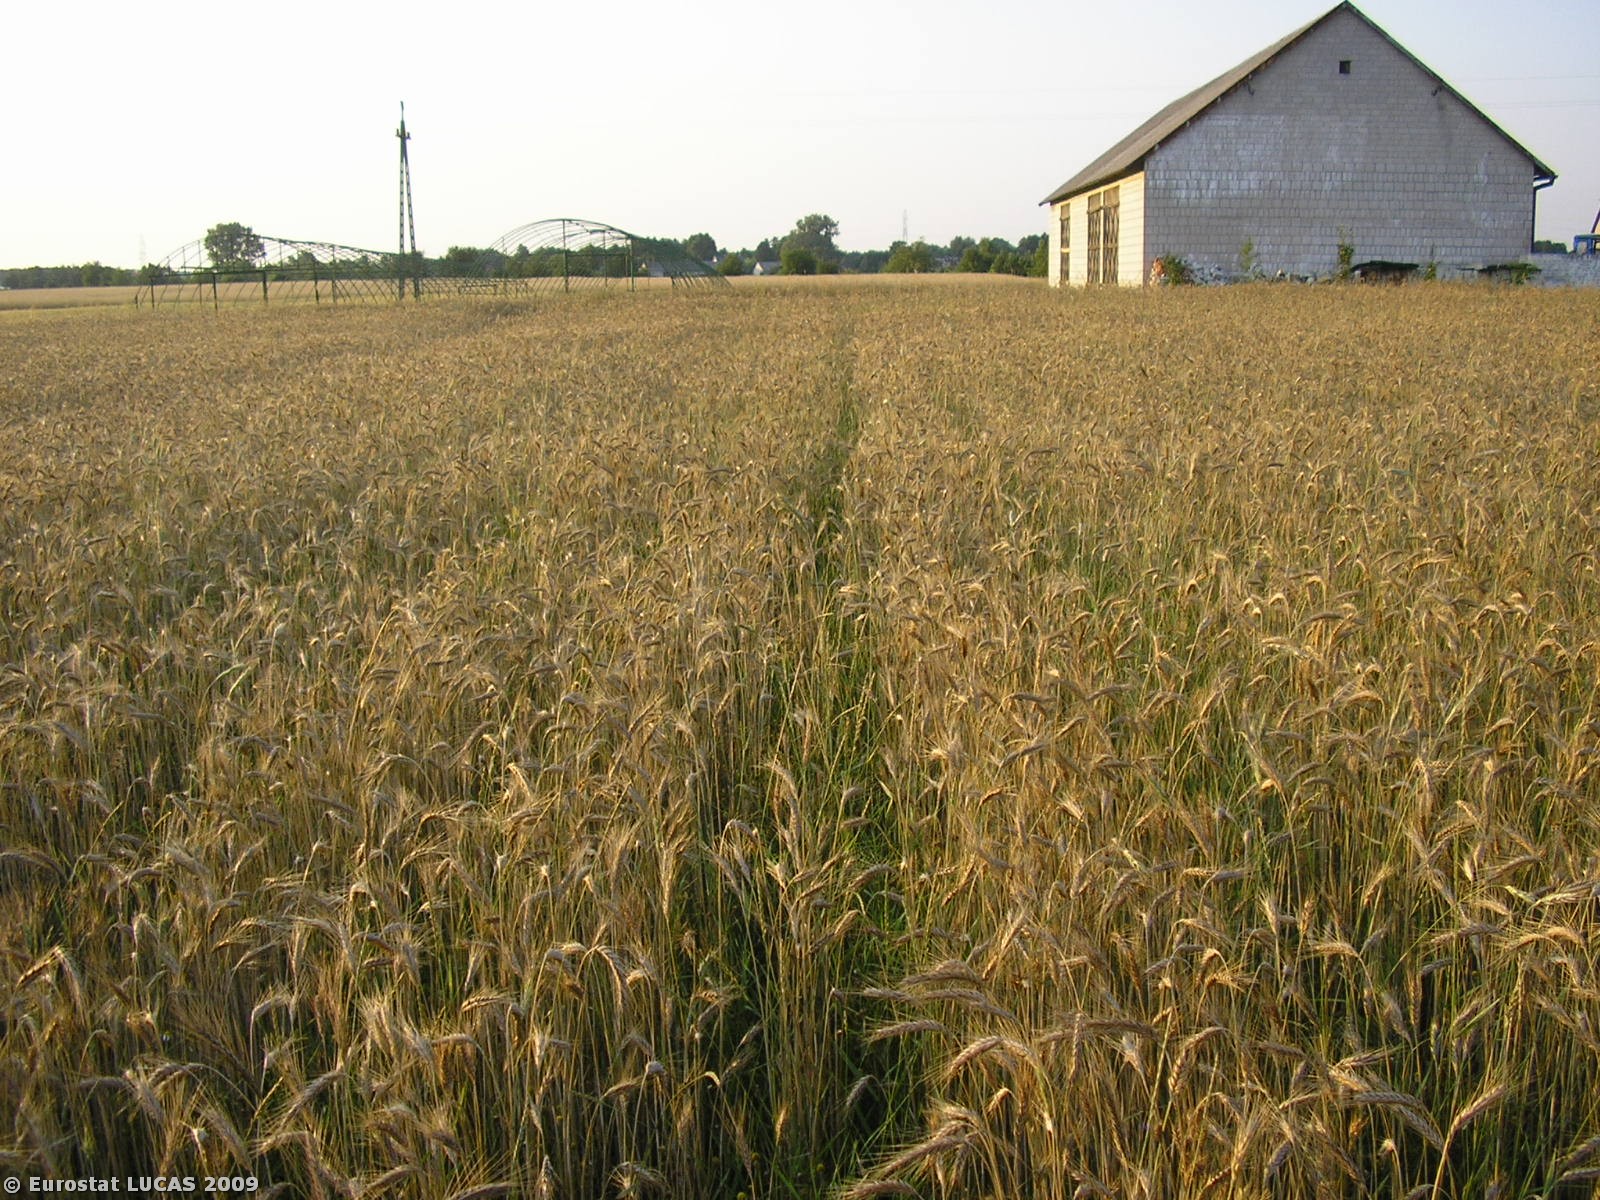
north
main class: Cropland
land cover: Triticale
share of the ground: > 75 %
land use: Agriculture (excluding fallow land and kitchen gardens)
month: July
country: PL
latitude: 52.4557
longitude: 20.8885
